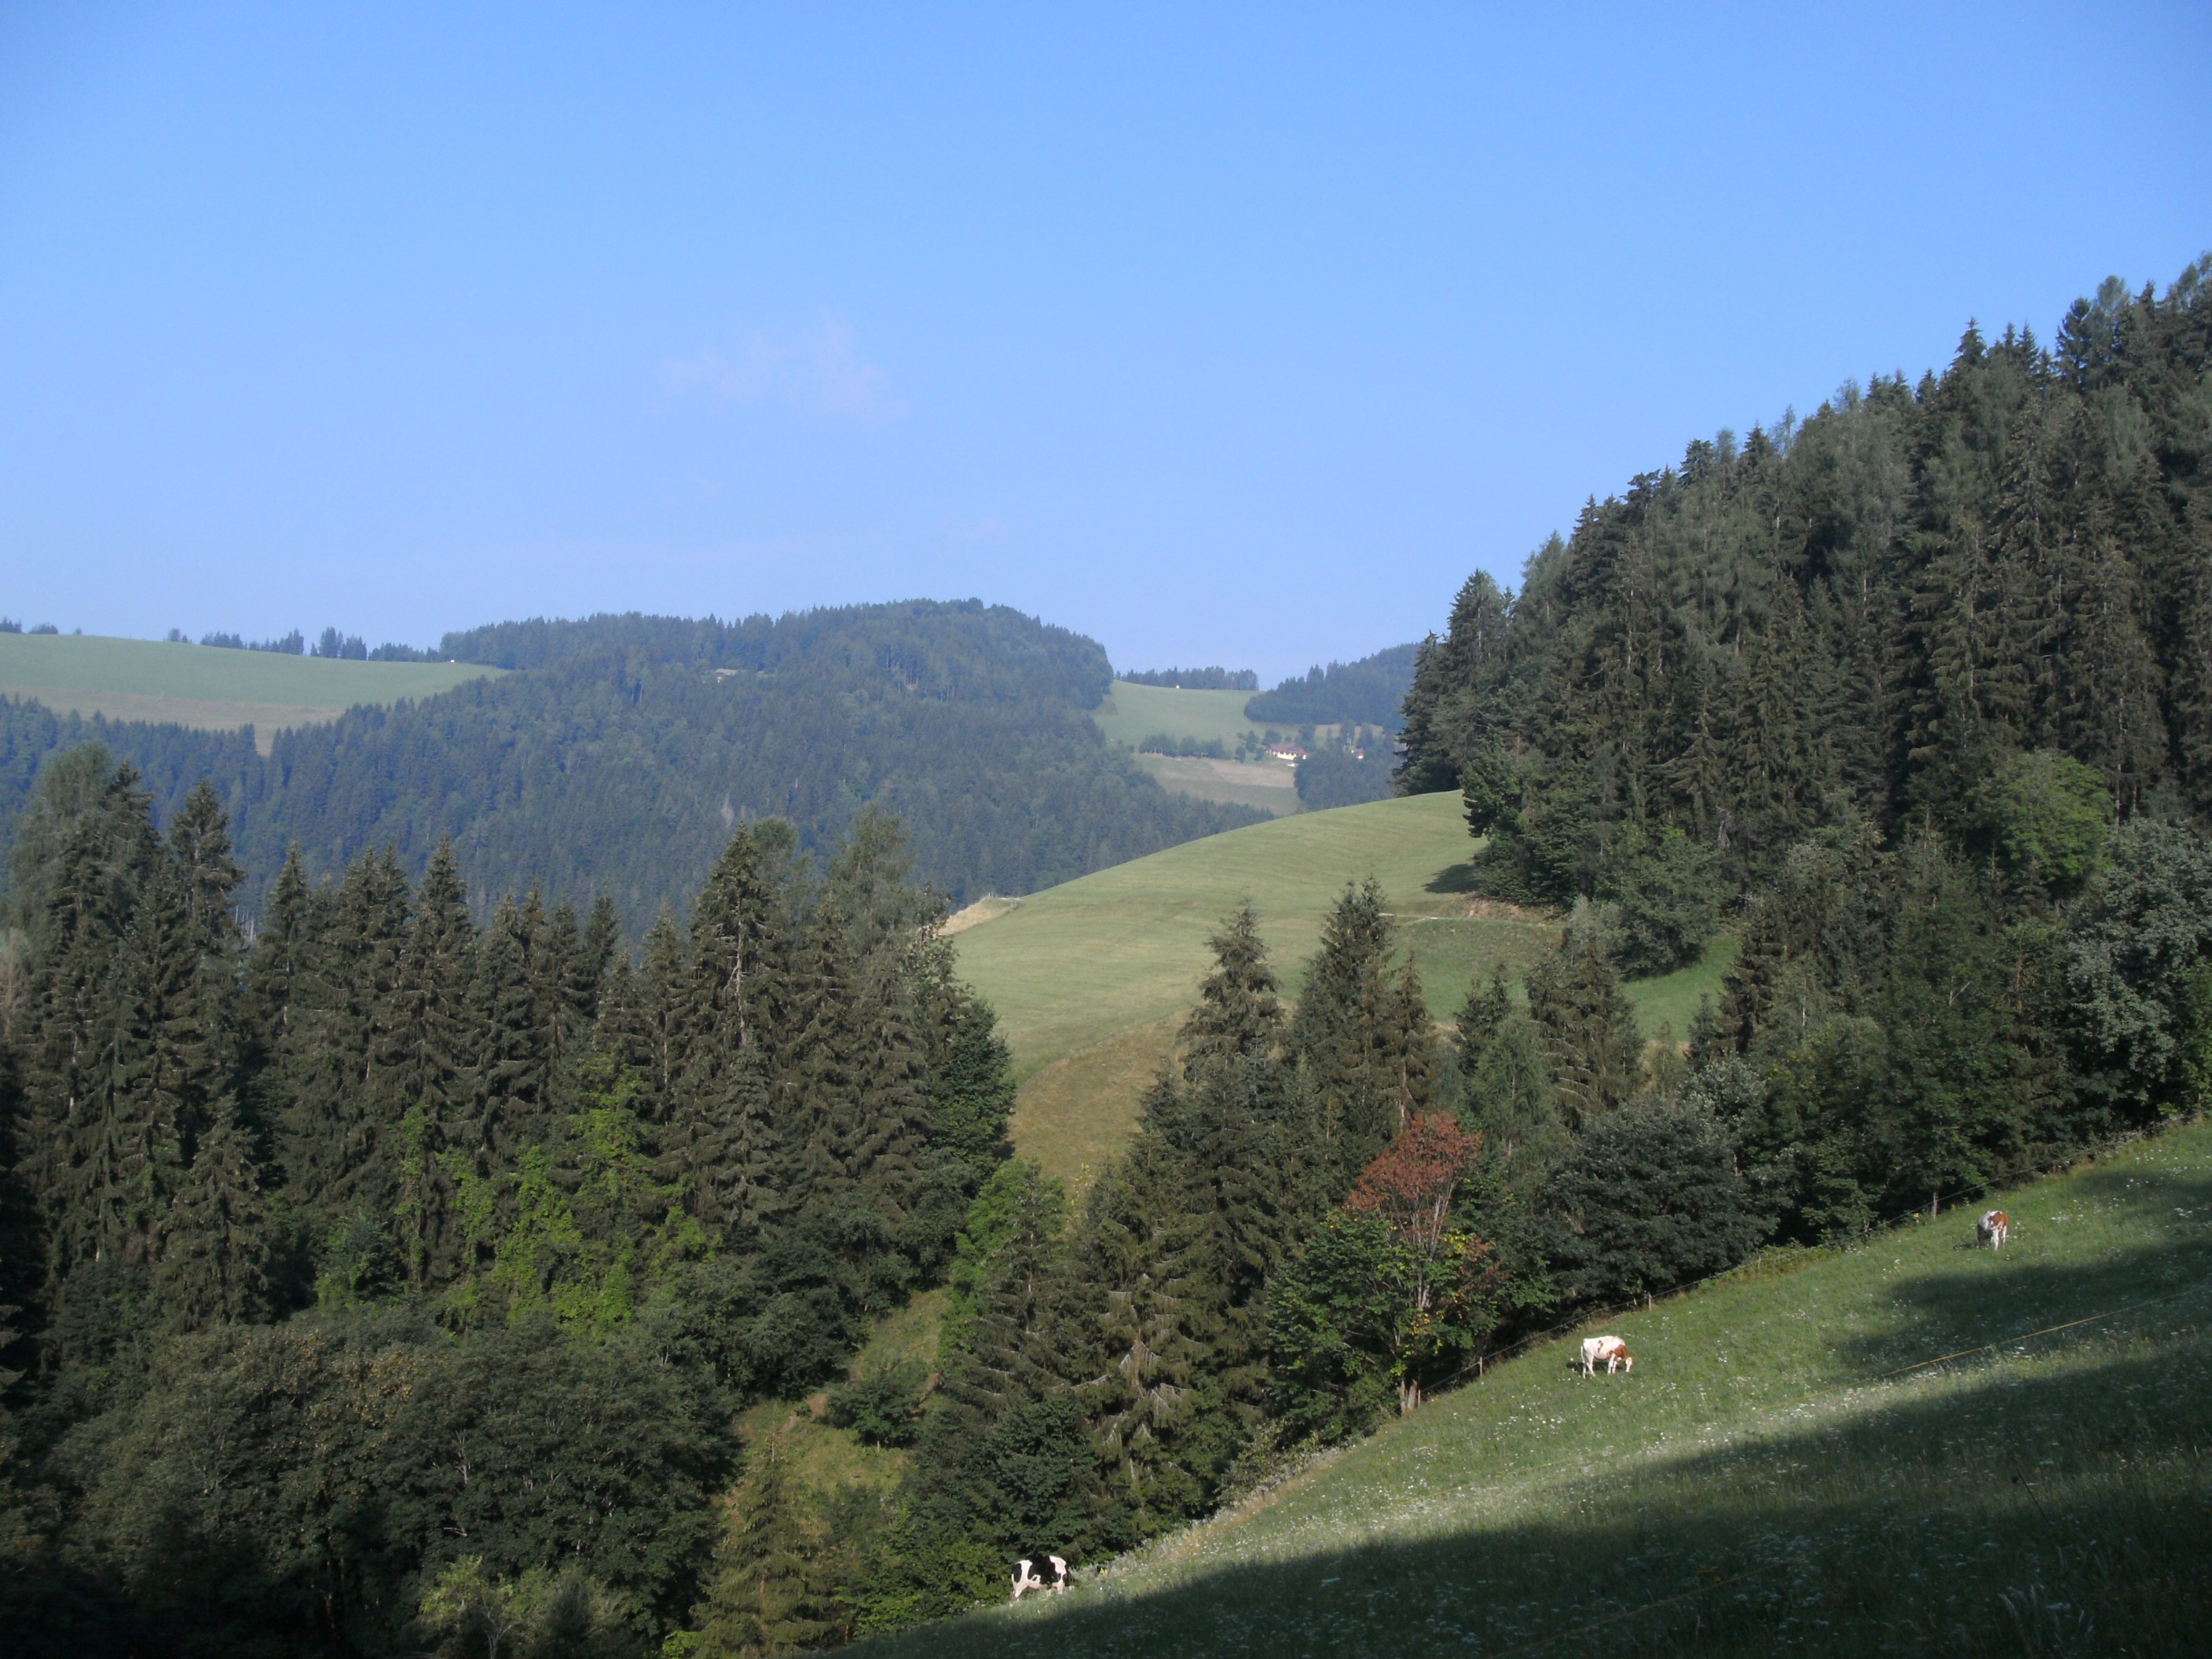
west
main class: Grassland
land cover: Grassland without tree/shrub cover
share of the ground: > 75 %
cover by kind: herbaceous plants 100 %
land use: Agriculture (excluding fallow land and kitchen gardens)
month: July
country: AT
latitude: 46.7340
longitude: 14.7222
